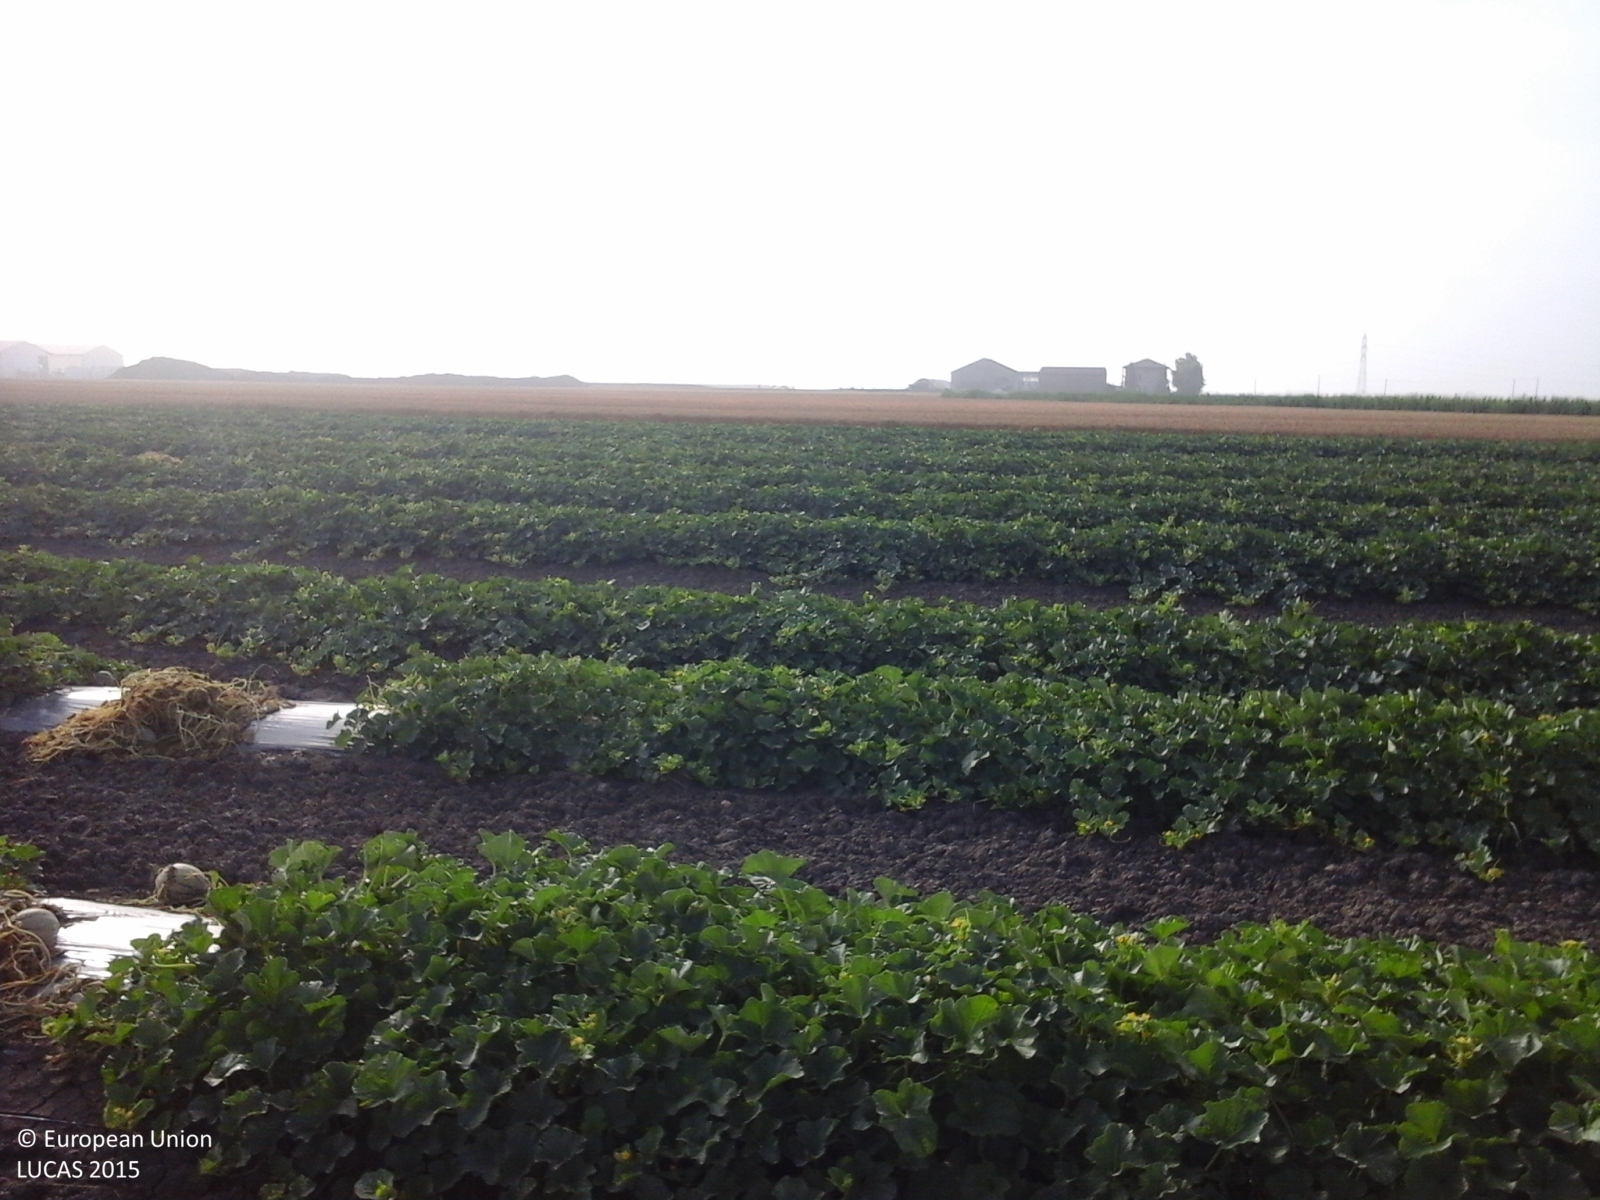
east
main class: Cropland
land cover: Other fresh vegetables
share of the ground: 50 - 75 %
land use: Agriculture (excluding fallow land and kitchen gardens)
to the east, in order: Other fresh vegetables; Ditches and canals; Other fresh vegetables; Grass margins; Ditches and canals; Grass margins; Common wheat; Ditches and canals; Common wheat; Ditches and canals; Common wheat; Ditches and canals; Common wheat; Ditches and canals; Common wheat; Ditches and canals; Common wheat; Ditches and canals; Common wheat
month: June
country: IT
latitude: 44.9396
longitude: 11.1257
